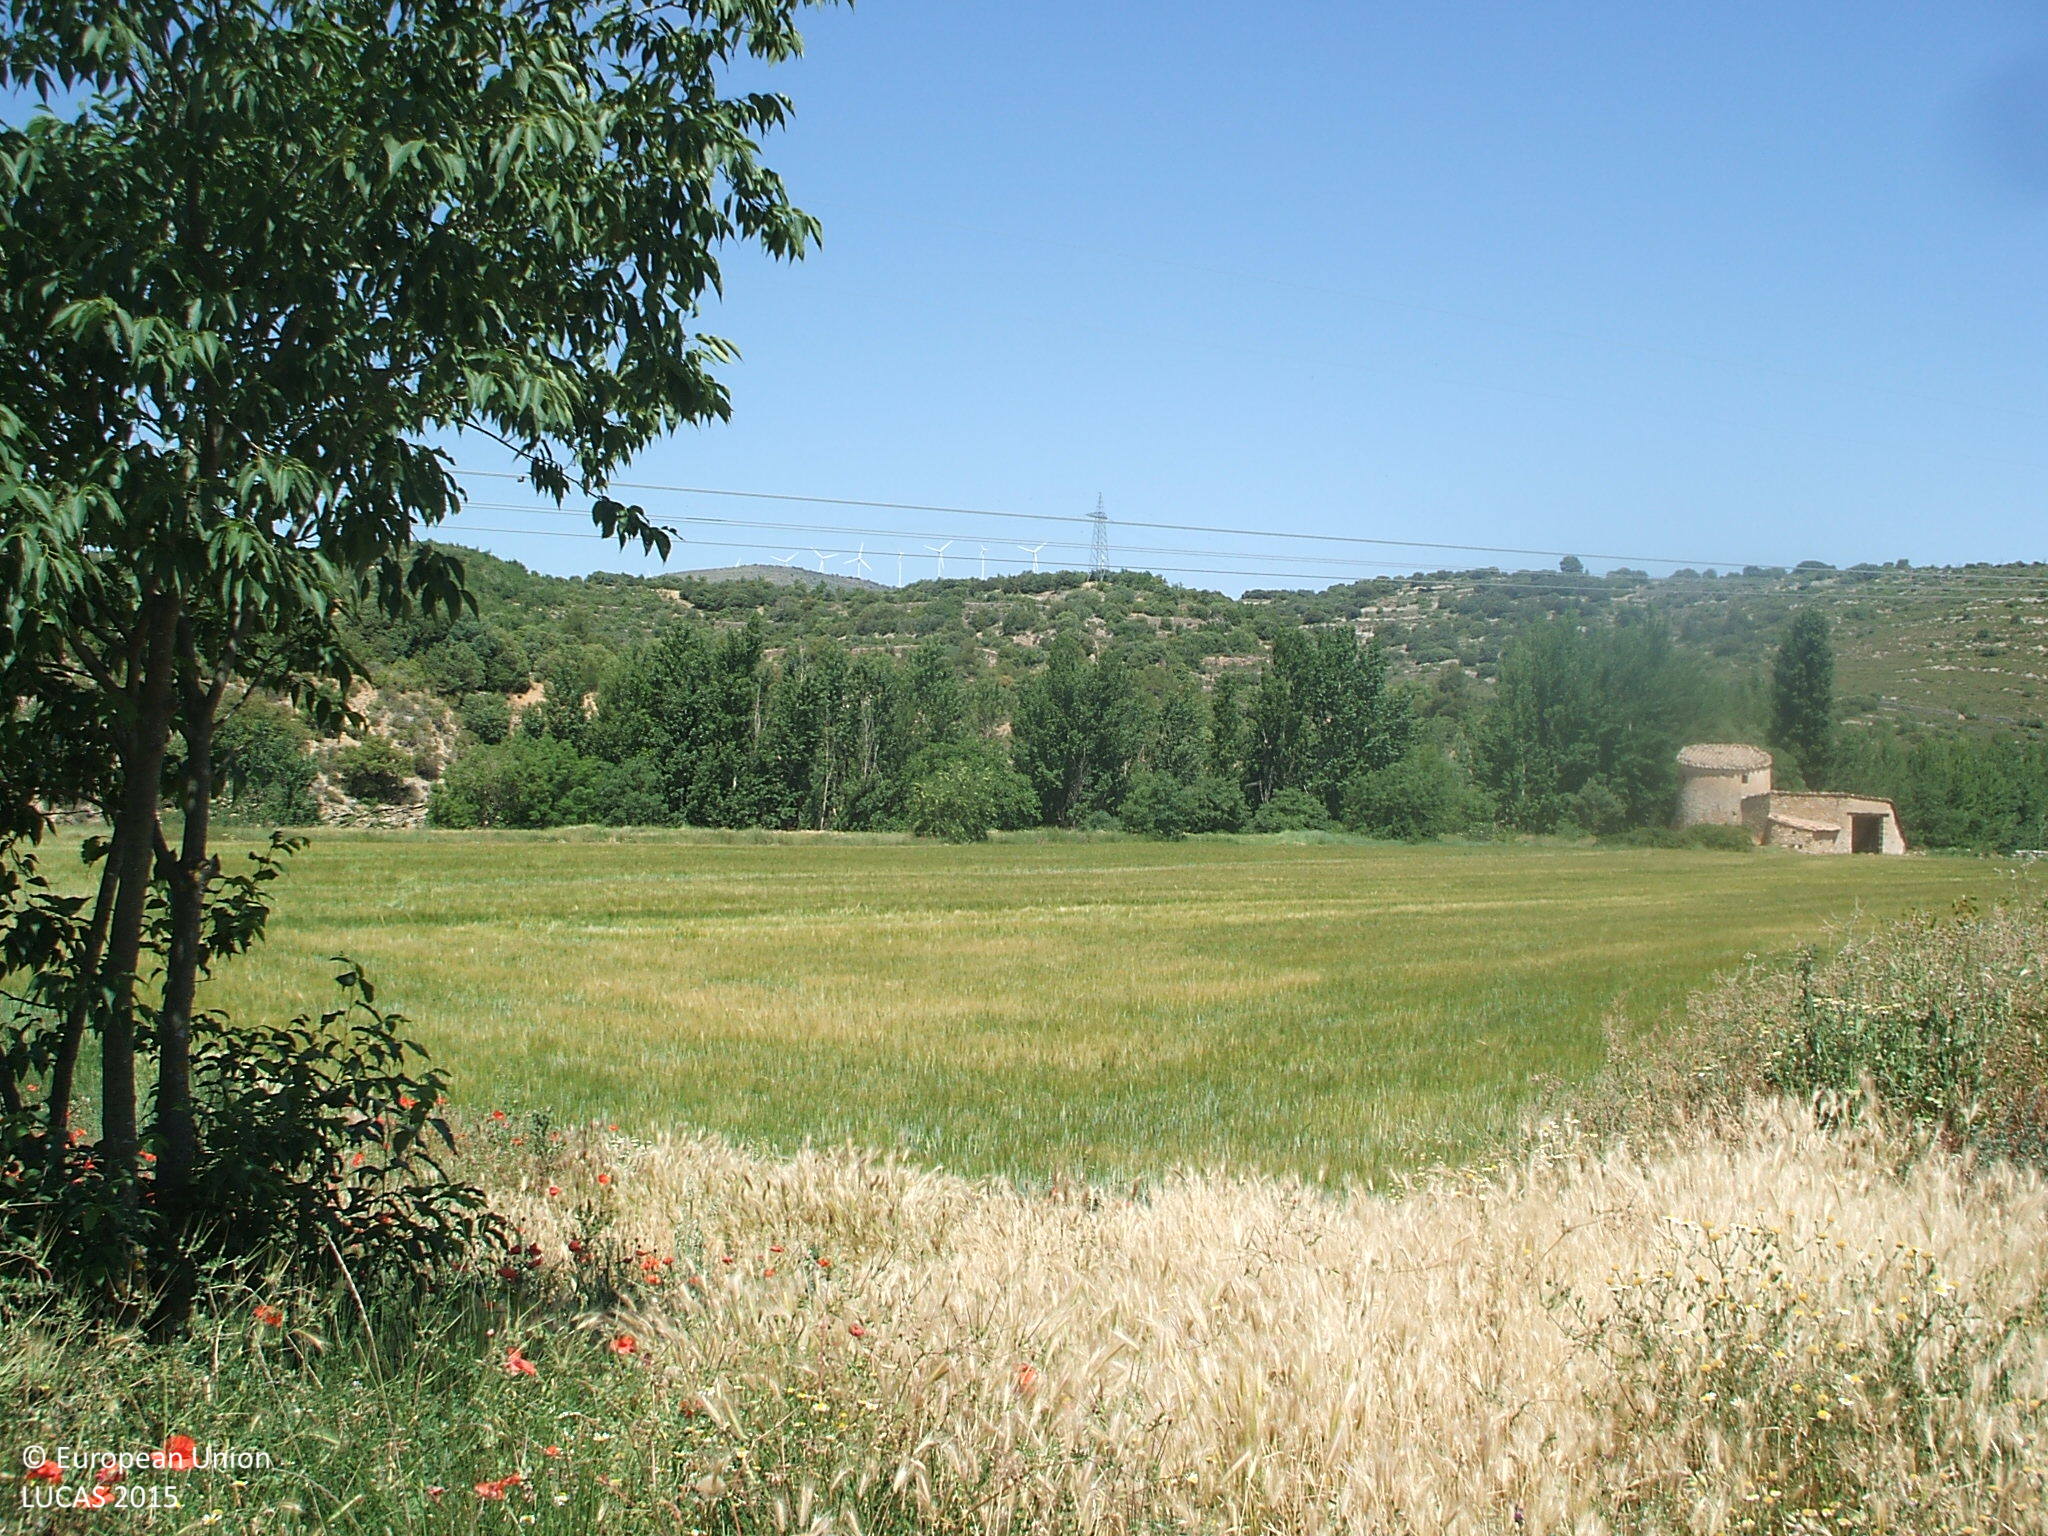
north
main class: Grassland
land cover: Spontaneously vegetated surfaces
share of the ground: > 75 %
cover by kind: herbaceous plants 100 %
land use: Fallow land
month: May
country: ES
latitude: 40.6643
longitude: -0.1927
